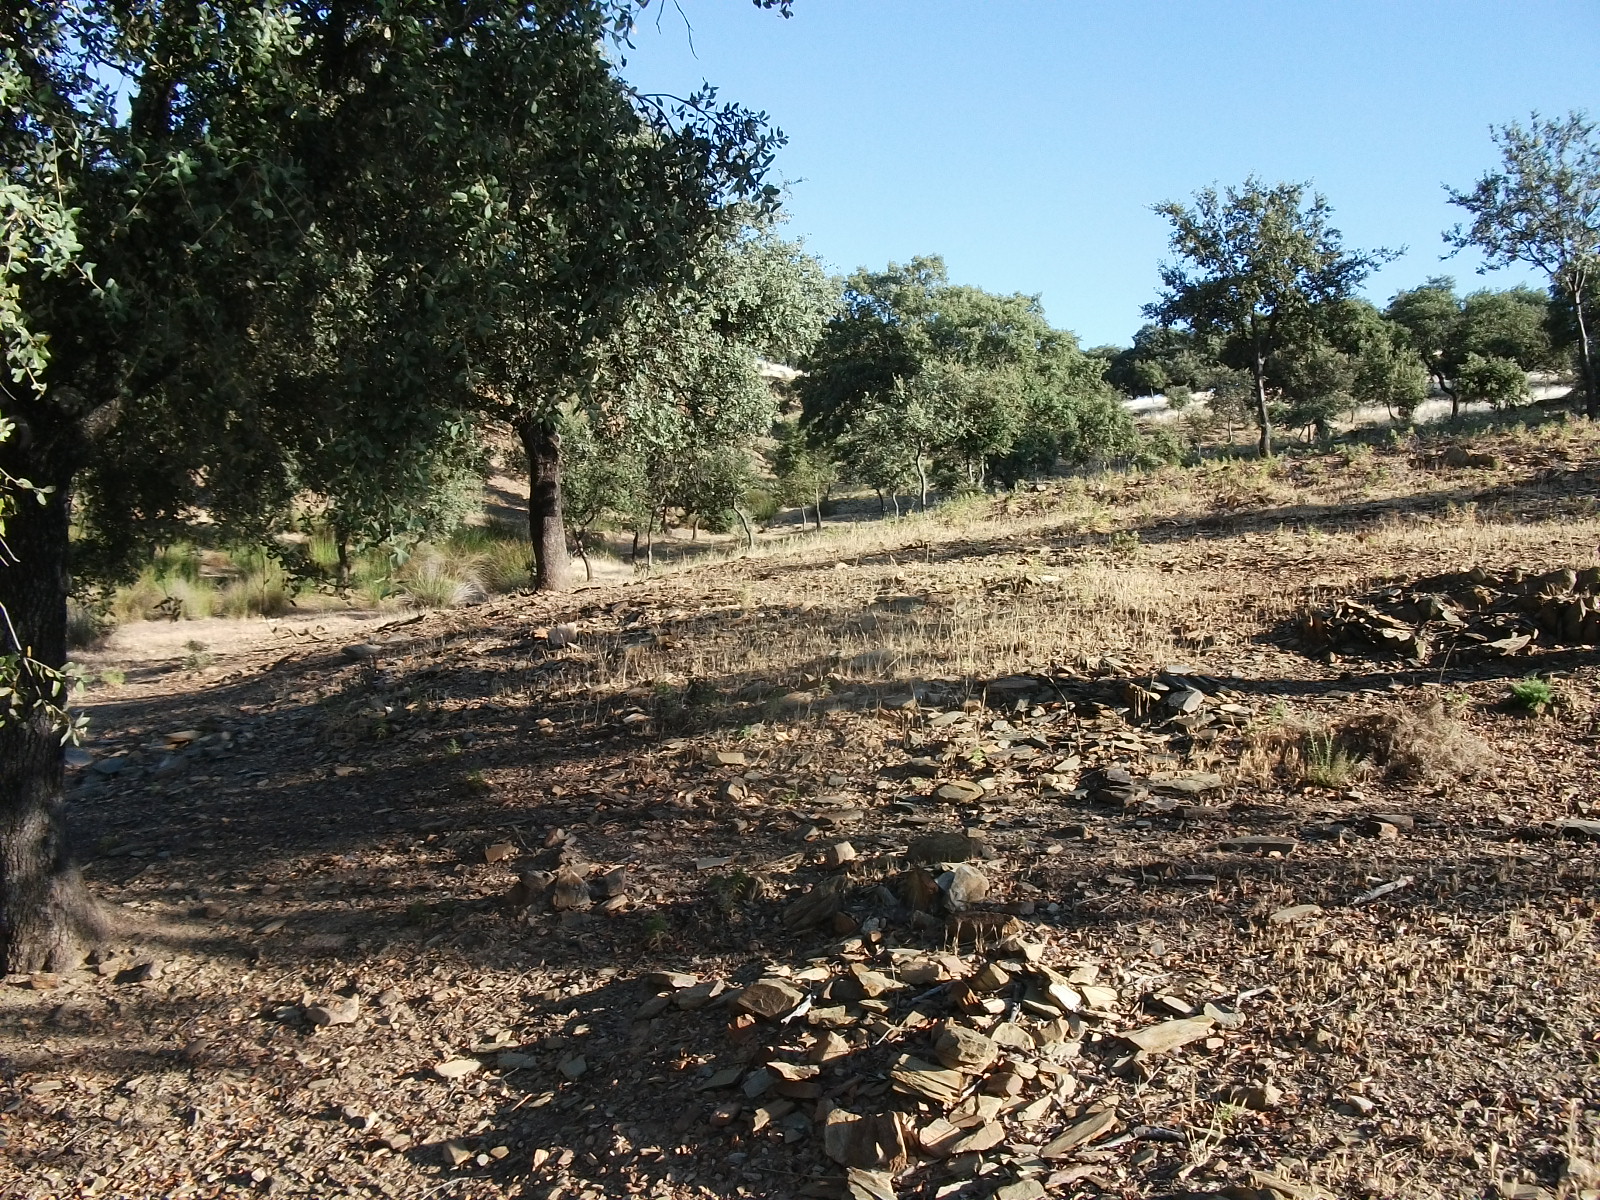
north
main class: Woodland
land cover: Broadleaved woodland
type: broadleaved evergreen forest
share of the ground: 50 - 75 %
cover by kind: broadleaved forest trees 70 %, herbaceous plants 20 %, unconsolidated bare surface 10 %
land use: Agriculture (excluding fallow land and kitchen gardens)
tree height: < 5 m
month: June
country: ES
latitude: 37.6609
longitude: -7.0176
